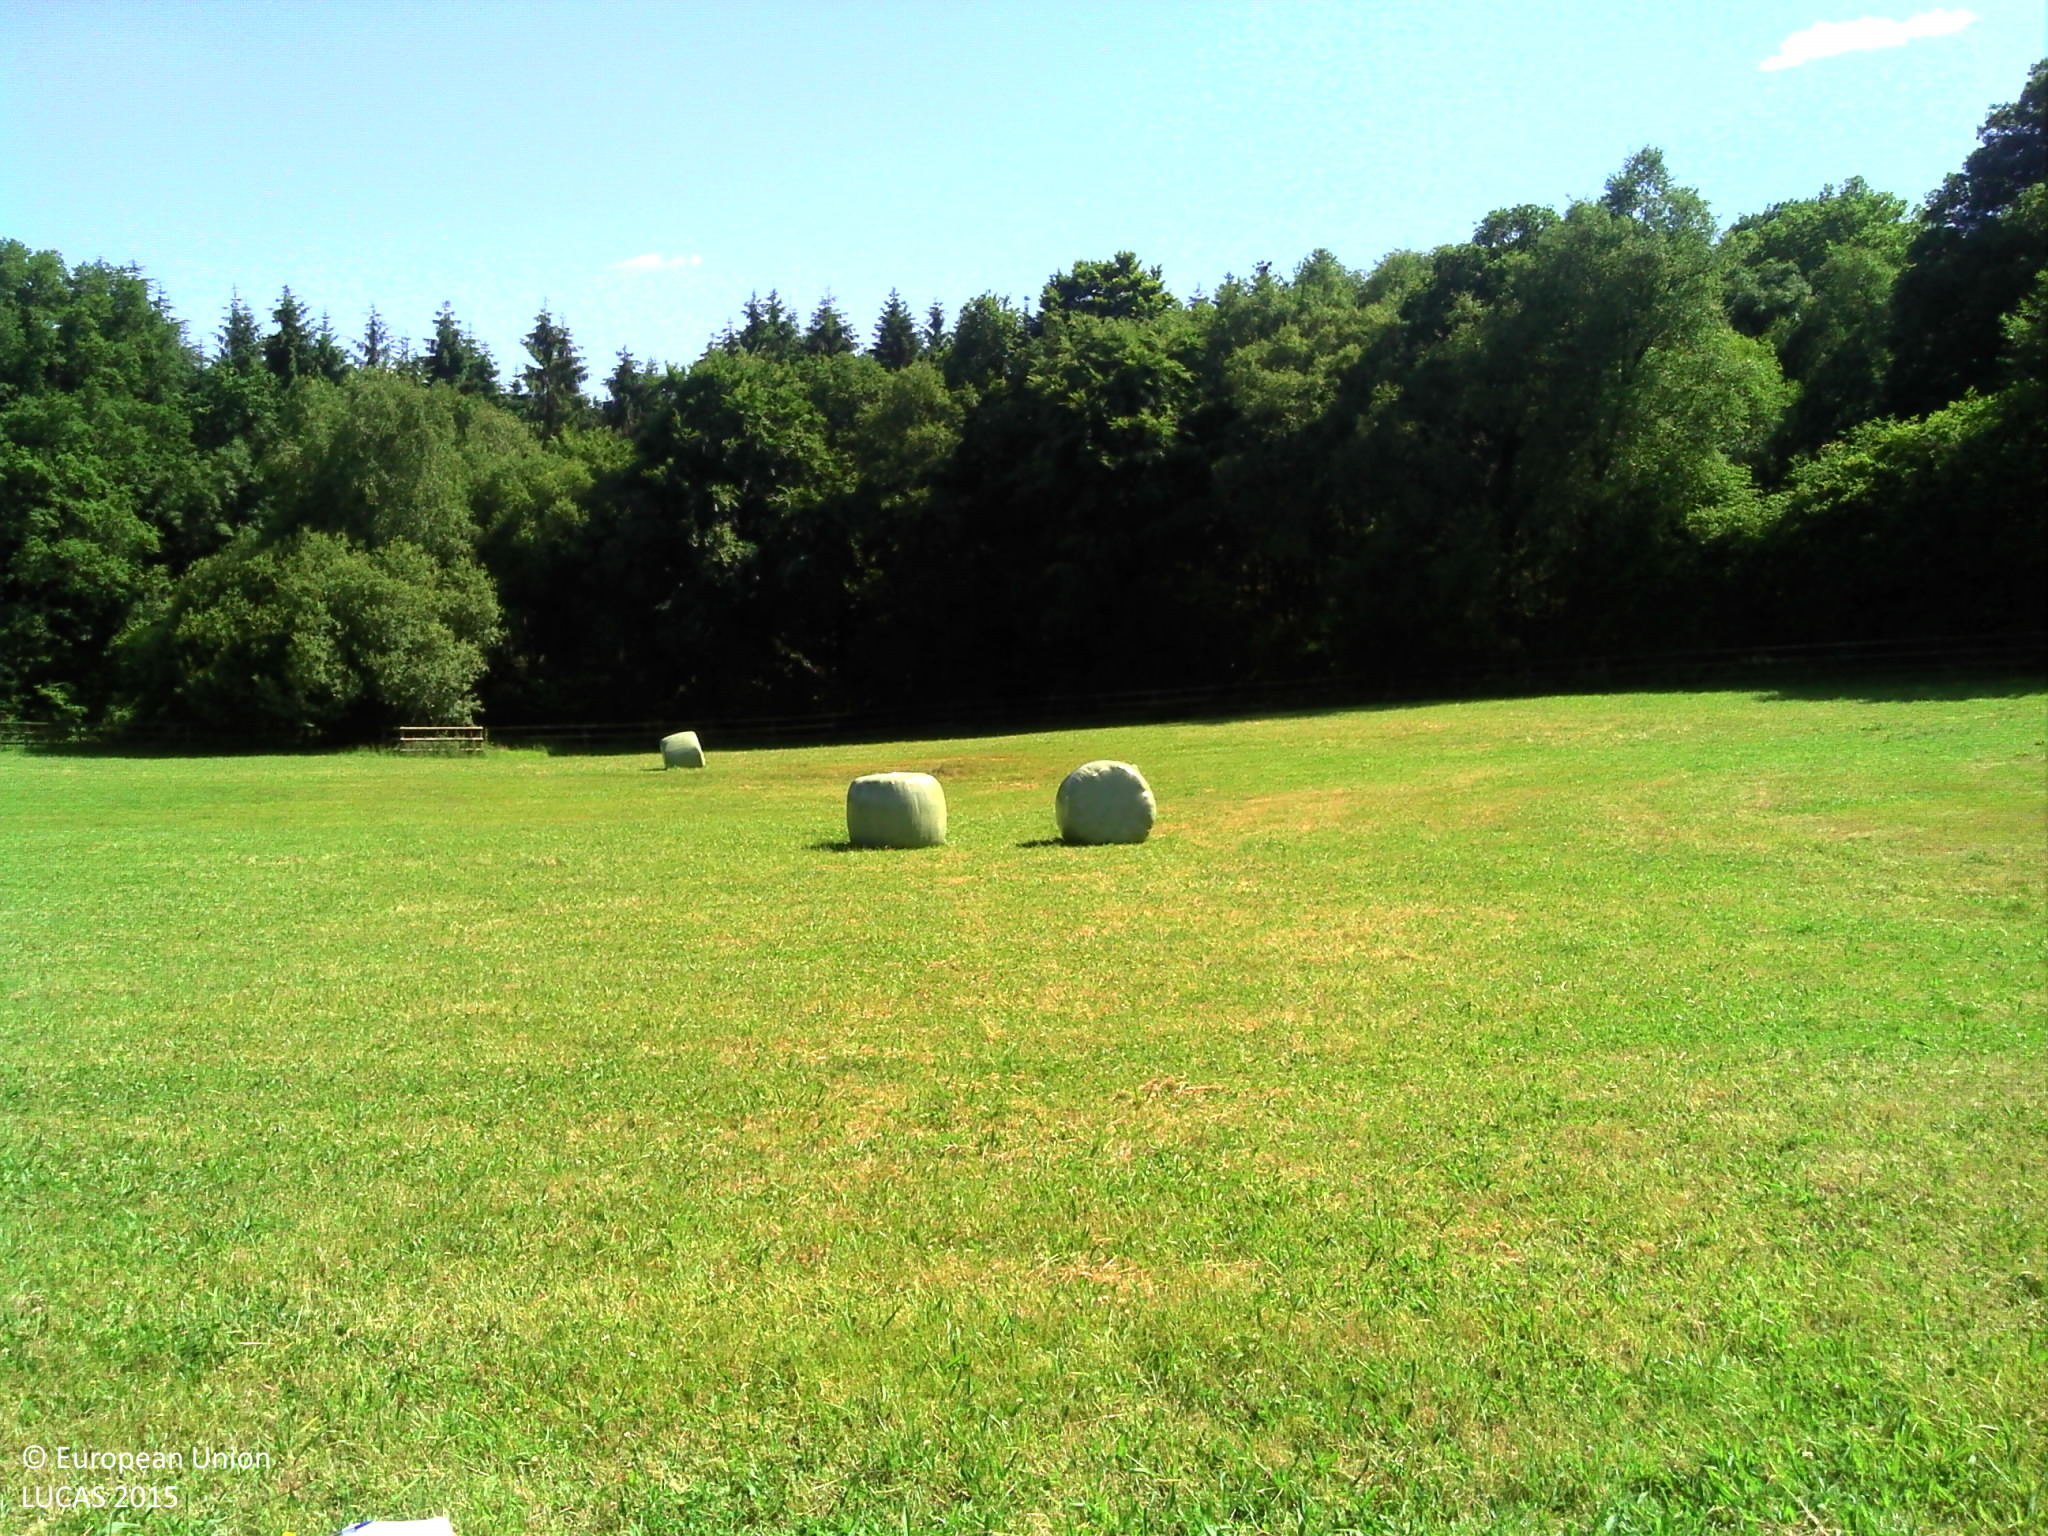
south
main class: Grassland
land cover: Grassland without tree/shrub cover
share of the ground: > 75 %
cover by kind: herbaceous plants 100 %
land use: Agriculture (excluding fallow land and kitchen gardens)
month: June
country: FR
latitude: 48.5558
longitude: 0.0943
